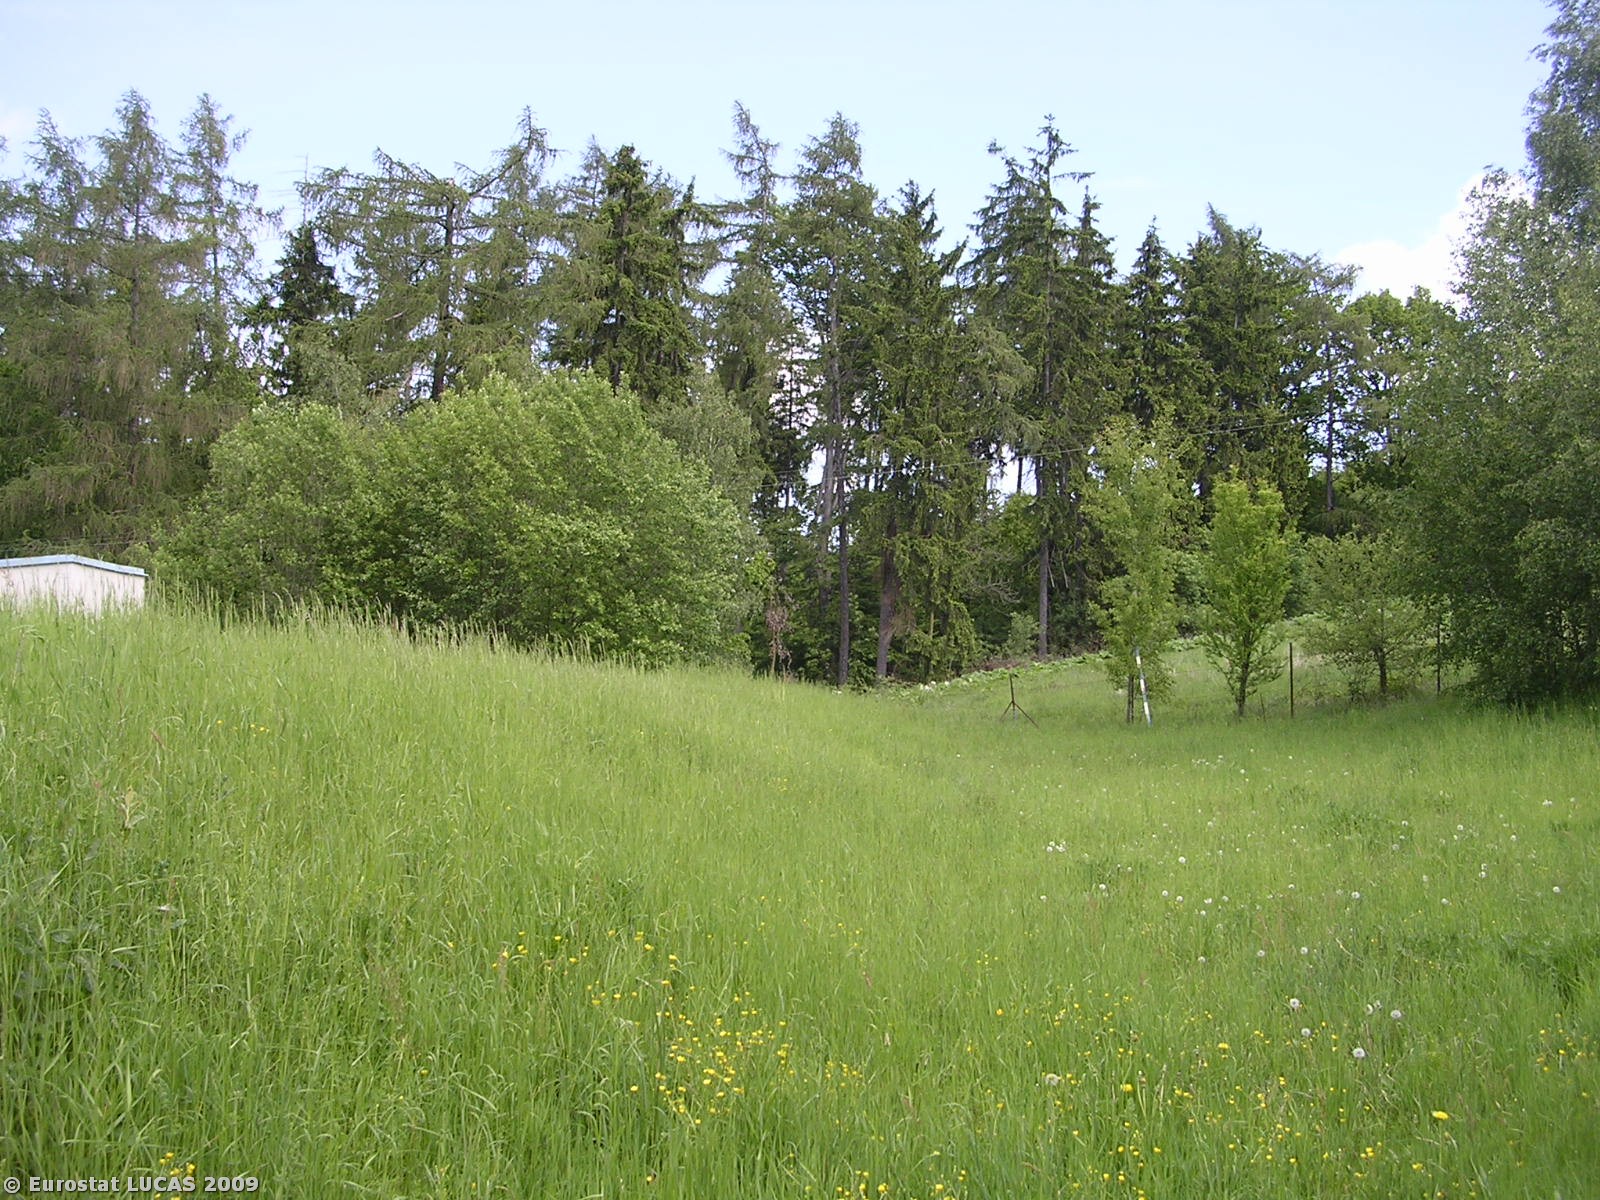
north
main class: Grassland
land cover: Grassland without tree/shrub cover
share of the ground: > 75 %
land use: Water supply and treatment
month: May
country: CZ
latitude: 49.9277
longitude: 14.6407
